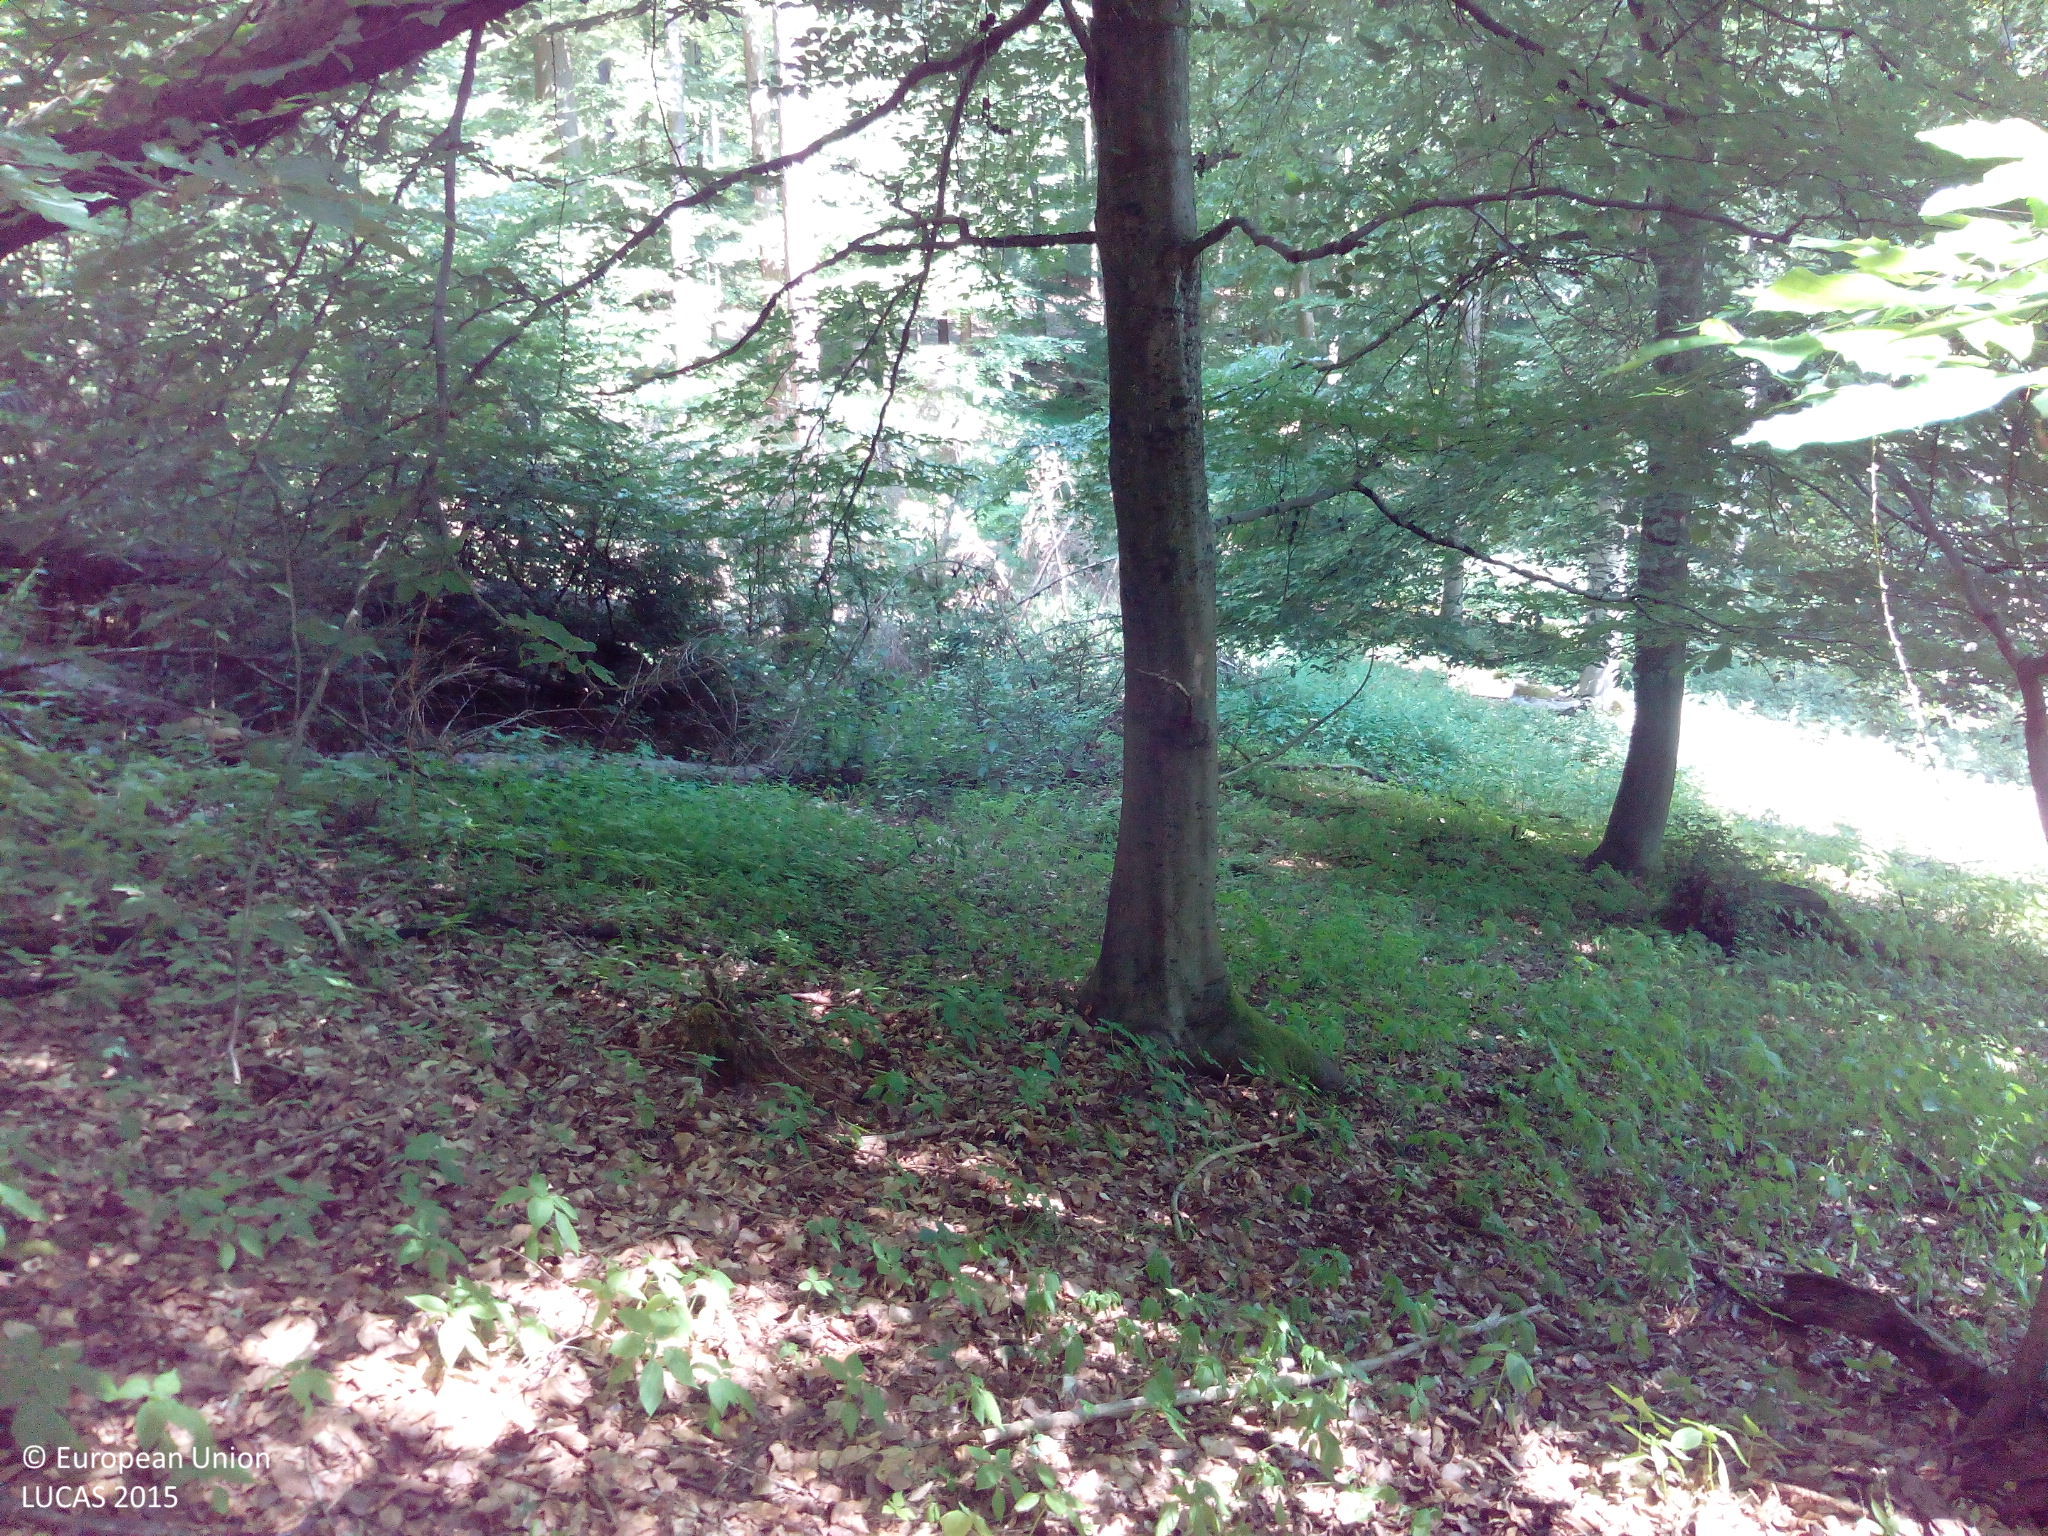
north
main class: Woodland
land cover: Spruce dominated mixed woodland
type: mesophytic deciduous forest
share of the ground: > 75 %
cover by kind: broadleaved forest trees 55 %, coniferous forest trees 30 %, herbaceous plants 10 %, unconsolidated bare surface 5 %
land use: Forestry
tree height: > 5 m
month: July
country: DE
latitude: 50.1133
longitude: 8.0286
